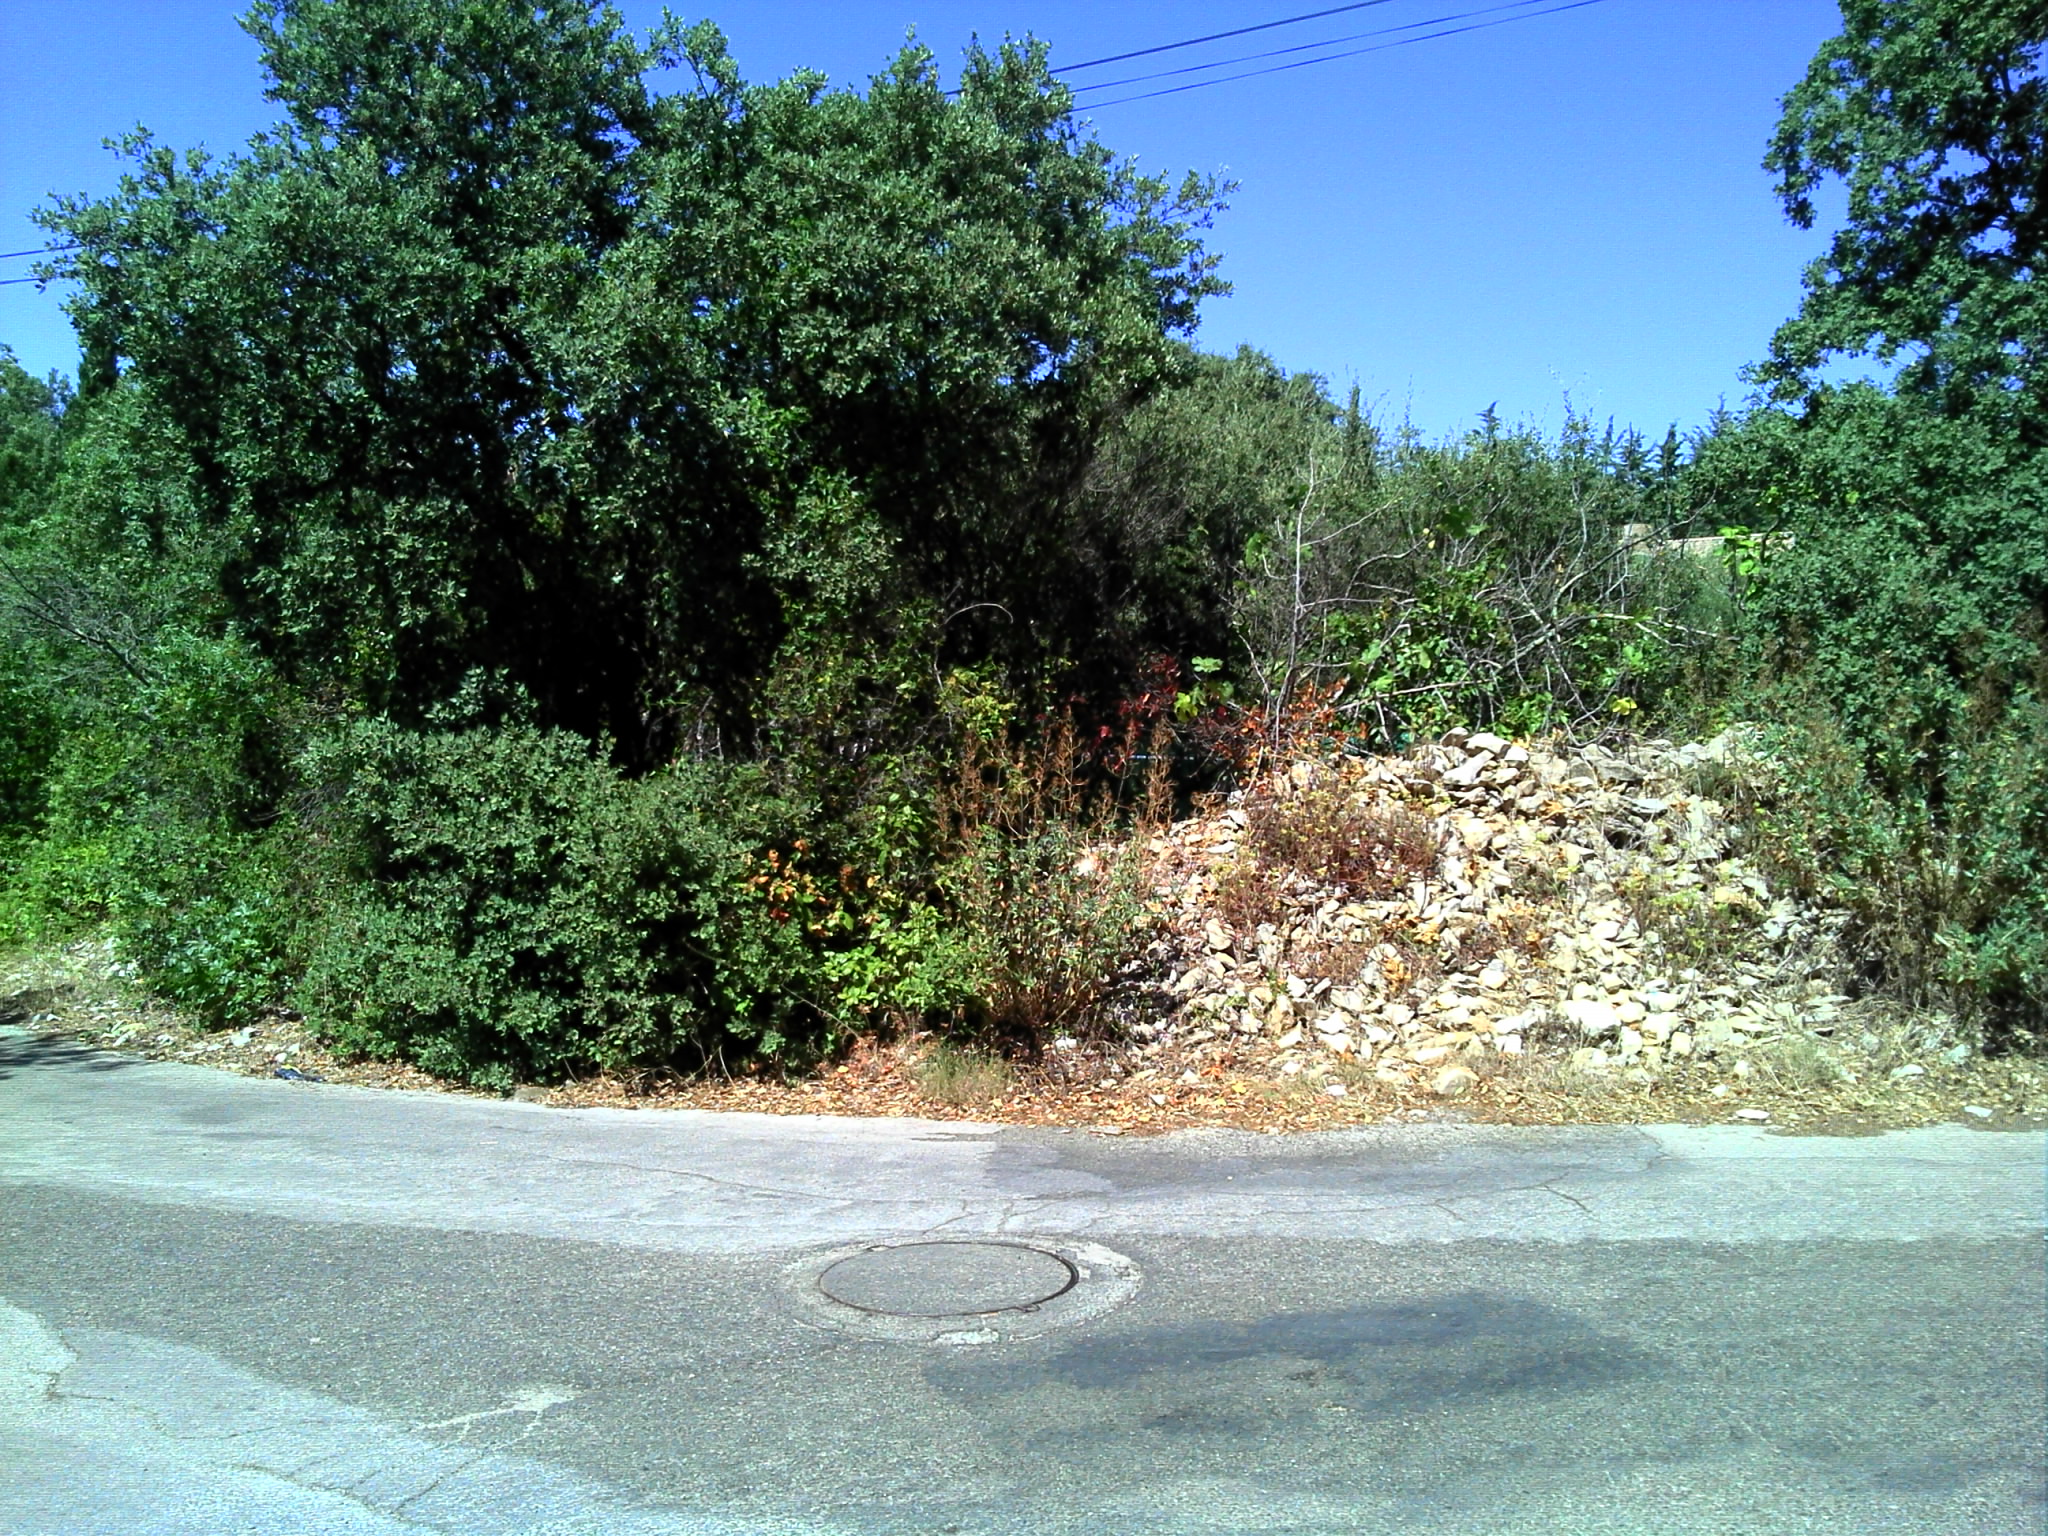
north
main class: Grassland
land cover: Grassland with sparse tree/shrub cover
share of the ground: > 75 %
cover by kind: herbaceous plants 95 %, broadleaved forest trees 5 %
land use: Residential
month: July
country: FR
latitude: 43.8517
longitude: 4.3236
